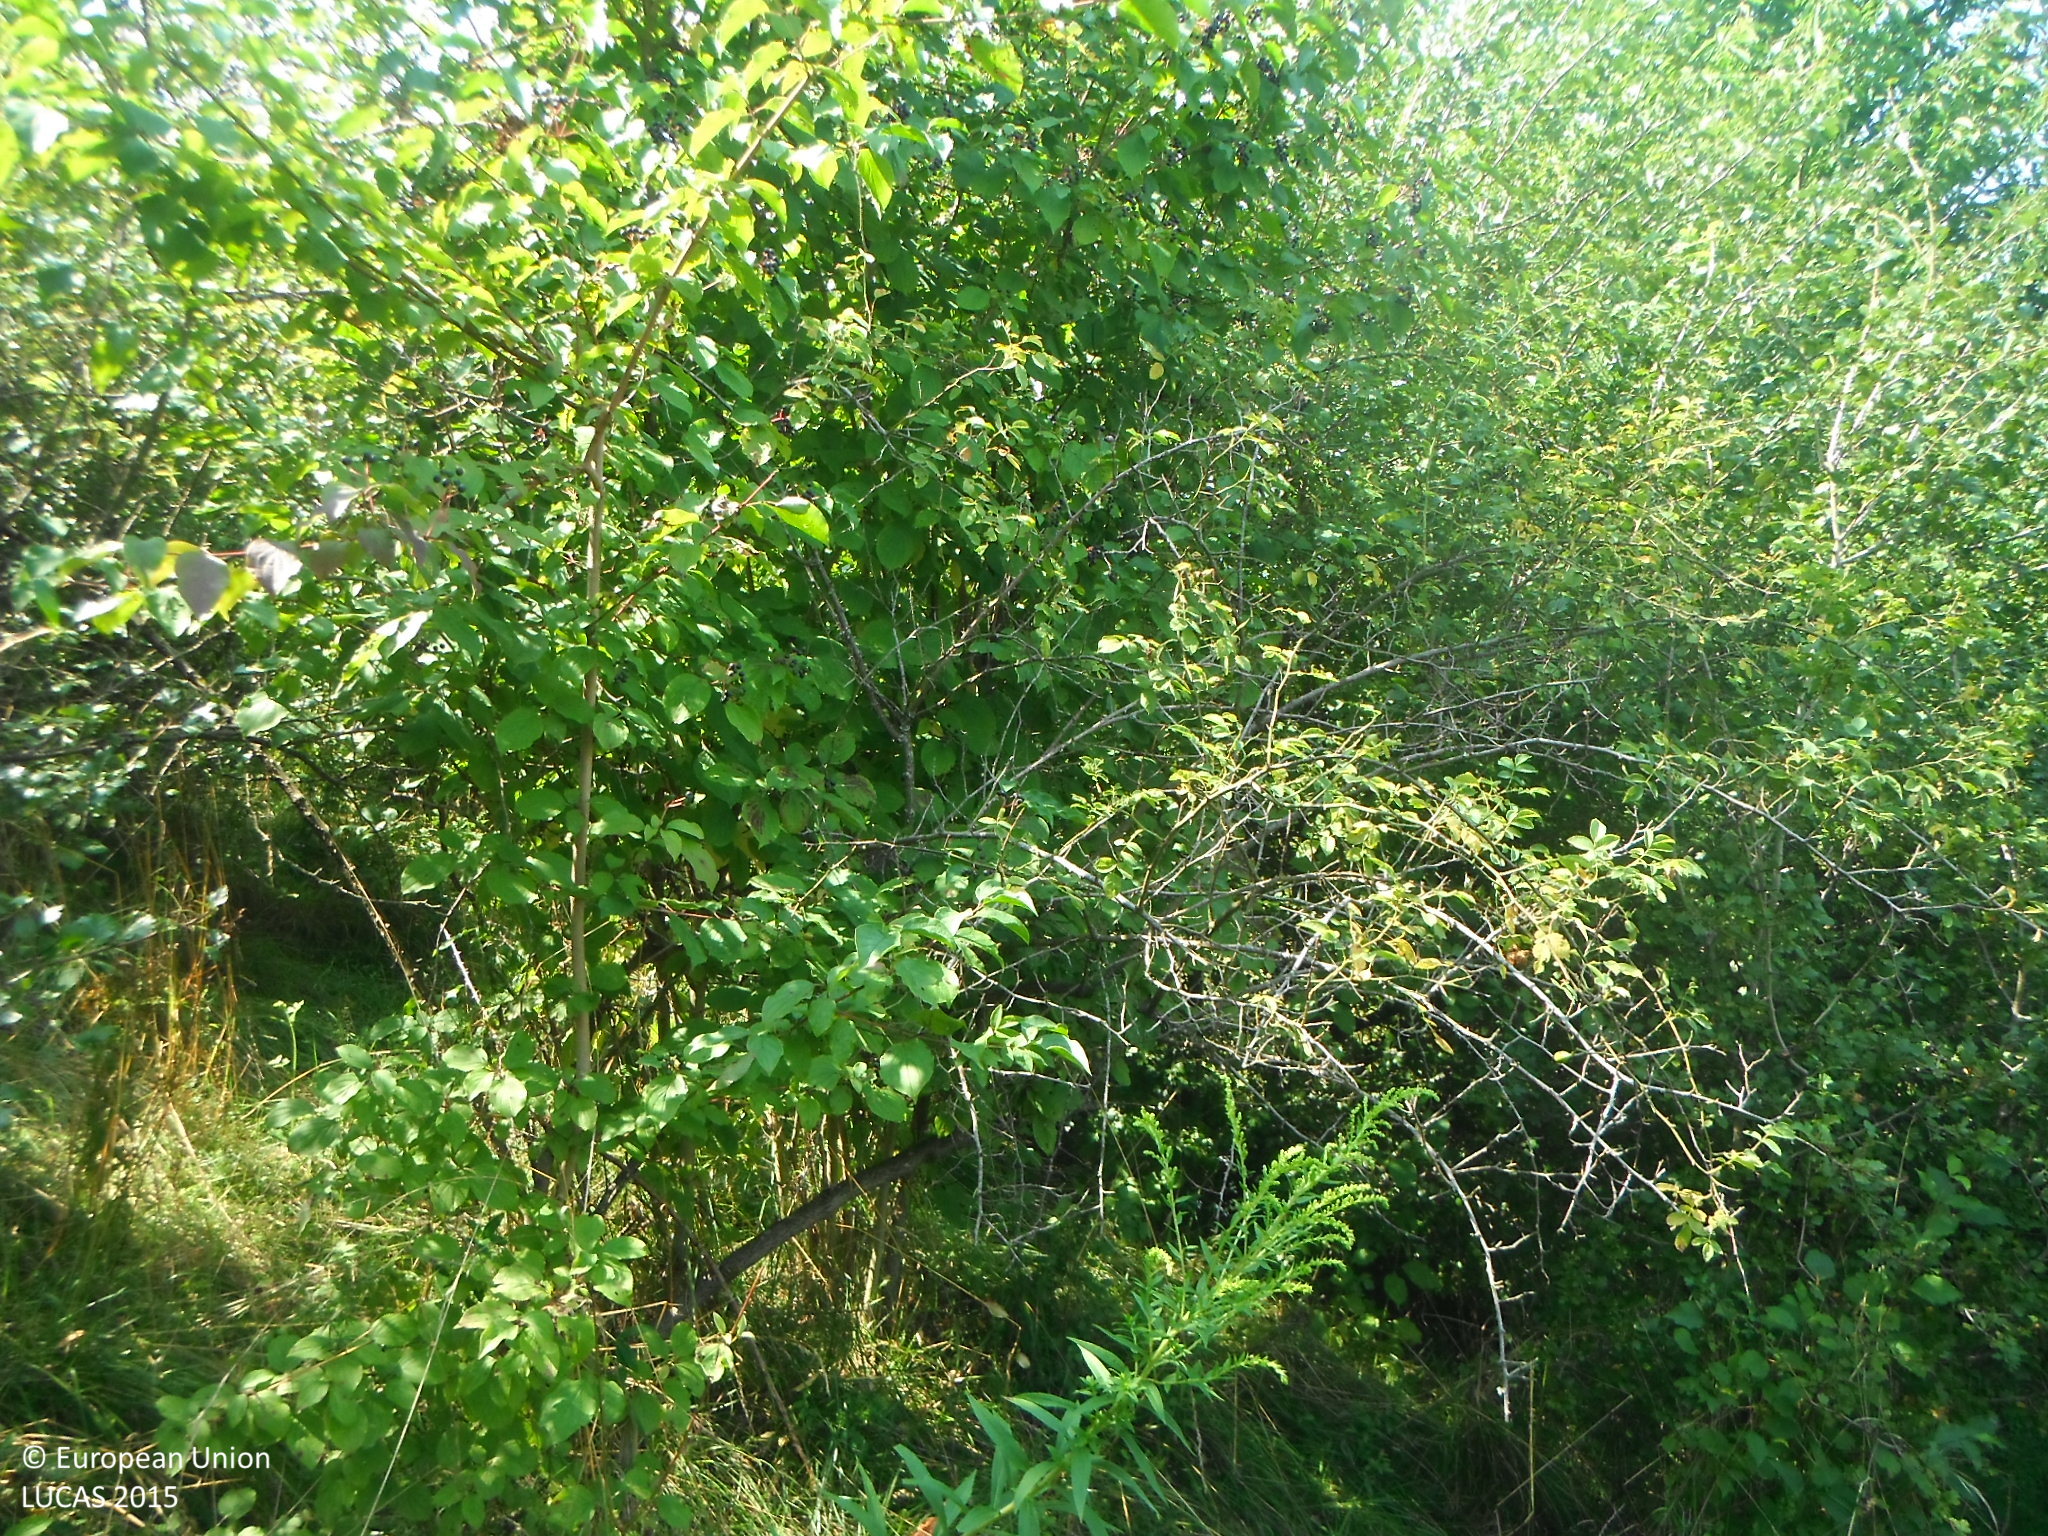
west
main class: Shrubland
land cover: Shrubland with sparse tree cover
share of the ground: > 75 %
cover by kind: shrubs 95 %, broadleaved forest trees 5 %
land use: Semi-natural and natural areas not in use
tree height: > 5 m
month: August
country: SK
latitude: 48.6257
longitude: 20.5230
